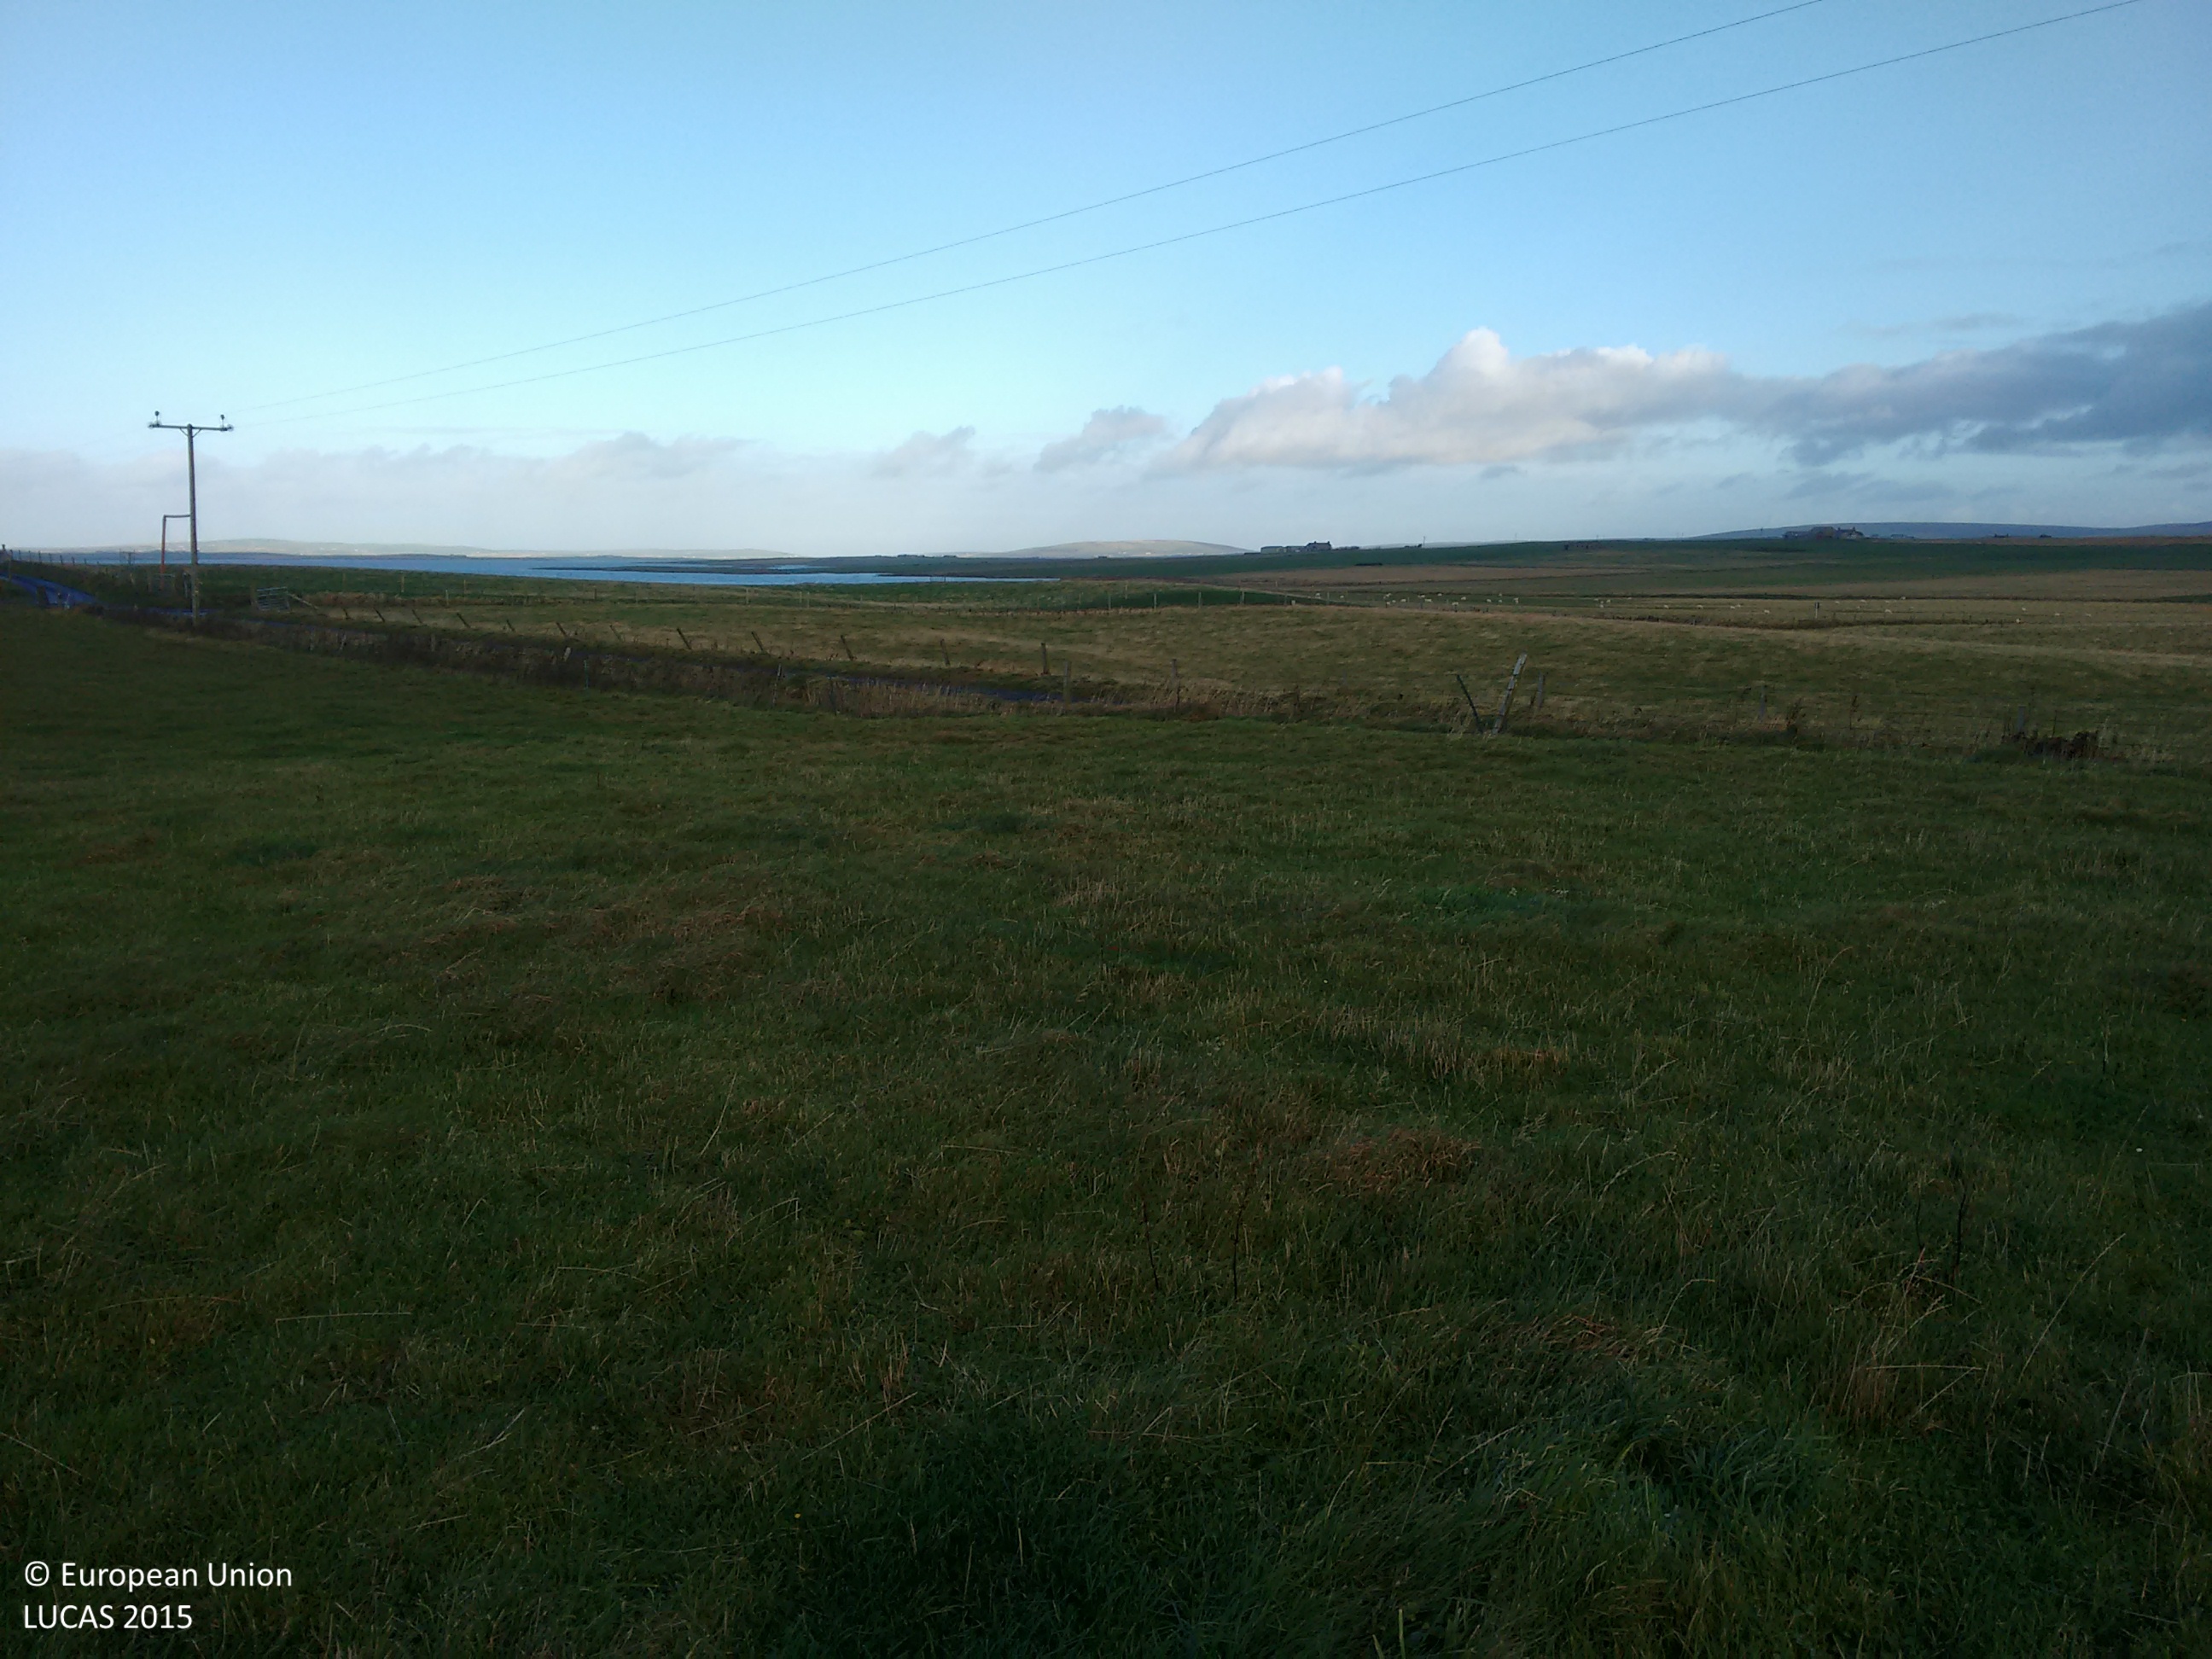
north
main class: Grassland
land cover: Grassland without tree/shrub cover
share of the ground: > 75 %
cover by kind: herbaceous plants 100 %
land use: Agriculture (excluding fallow land and kitchen gardens)
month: November
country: GB
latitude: 58.9903
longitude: -3.1948
